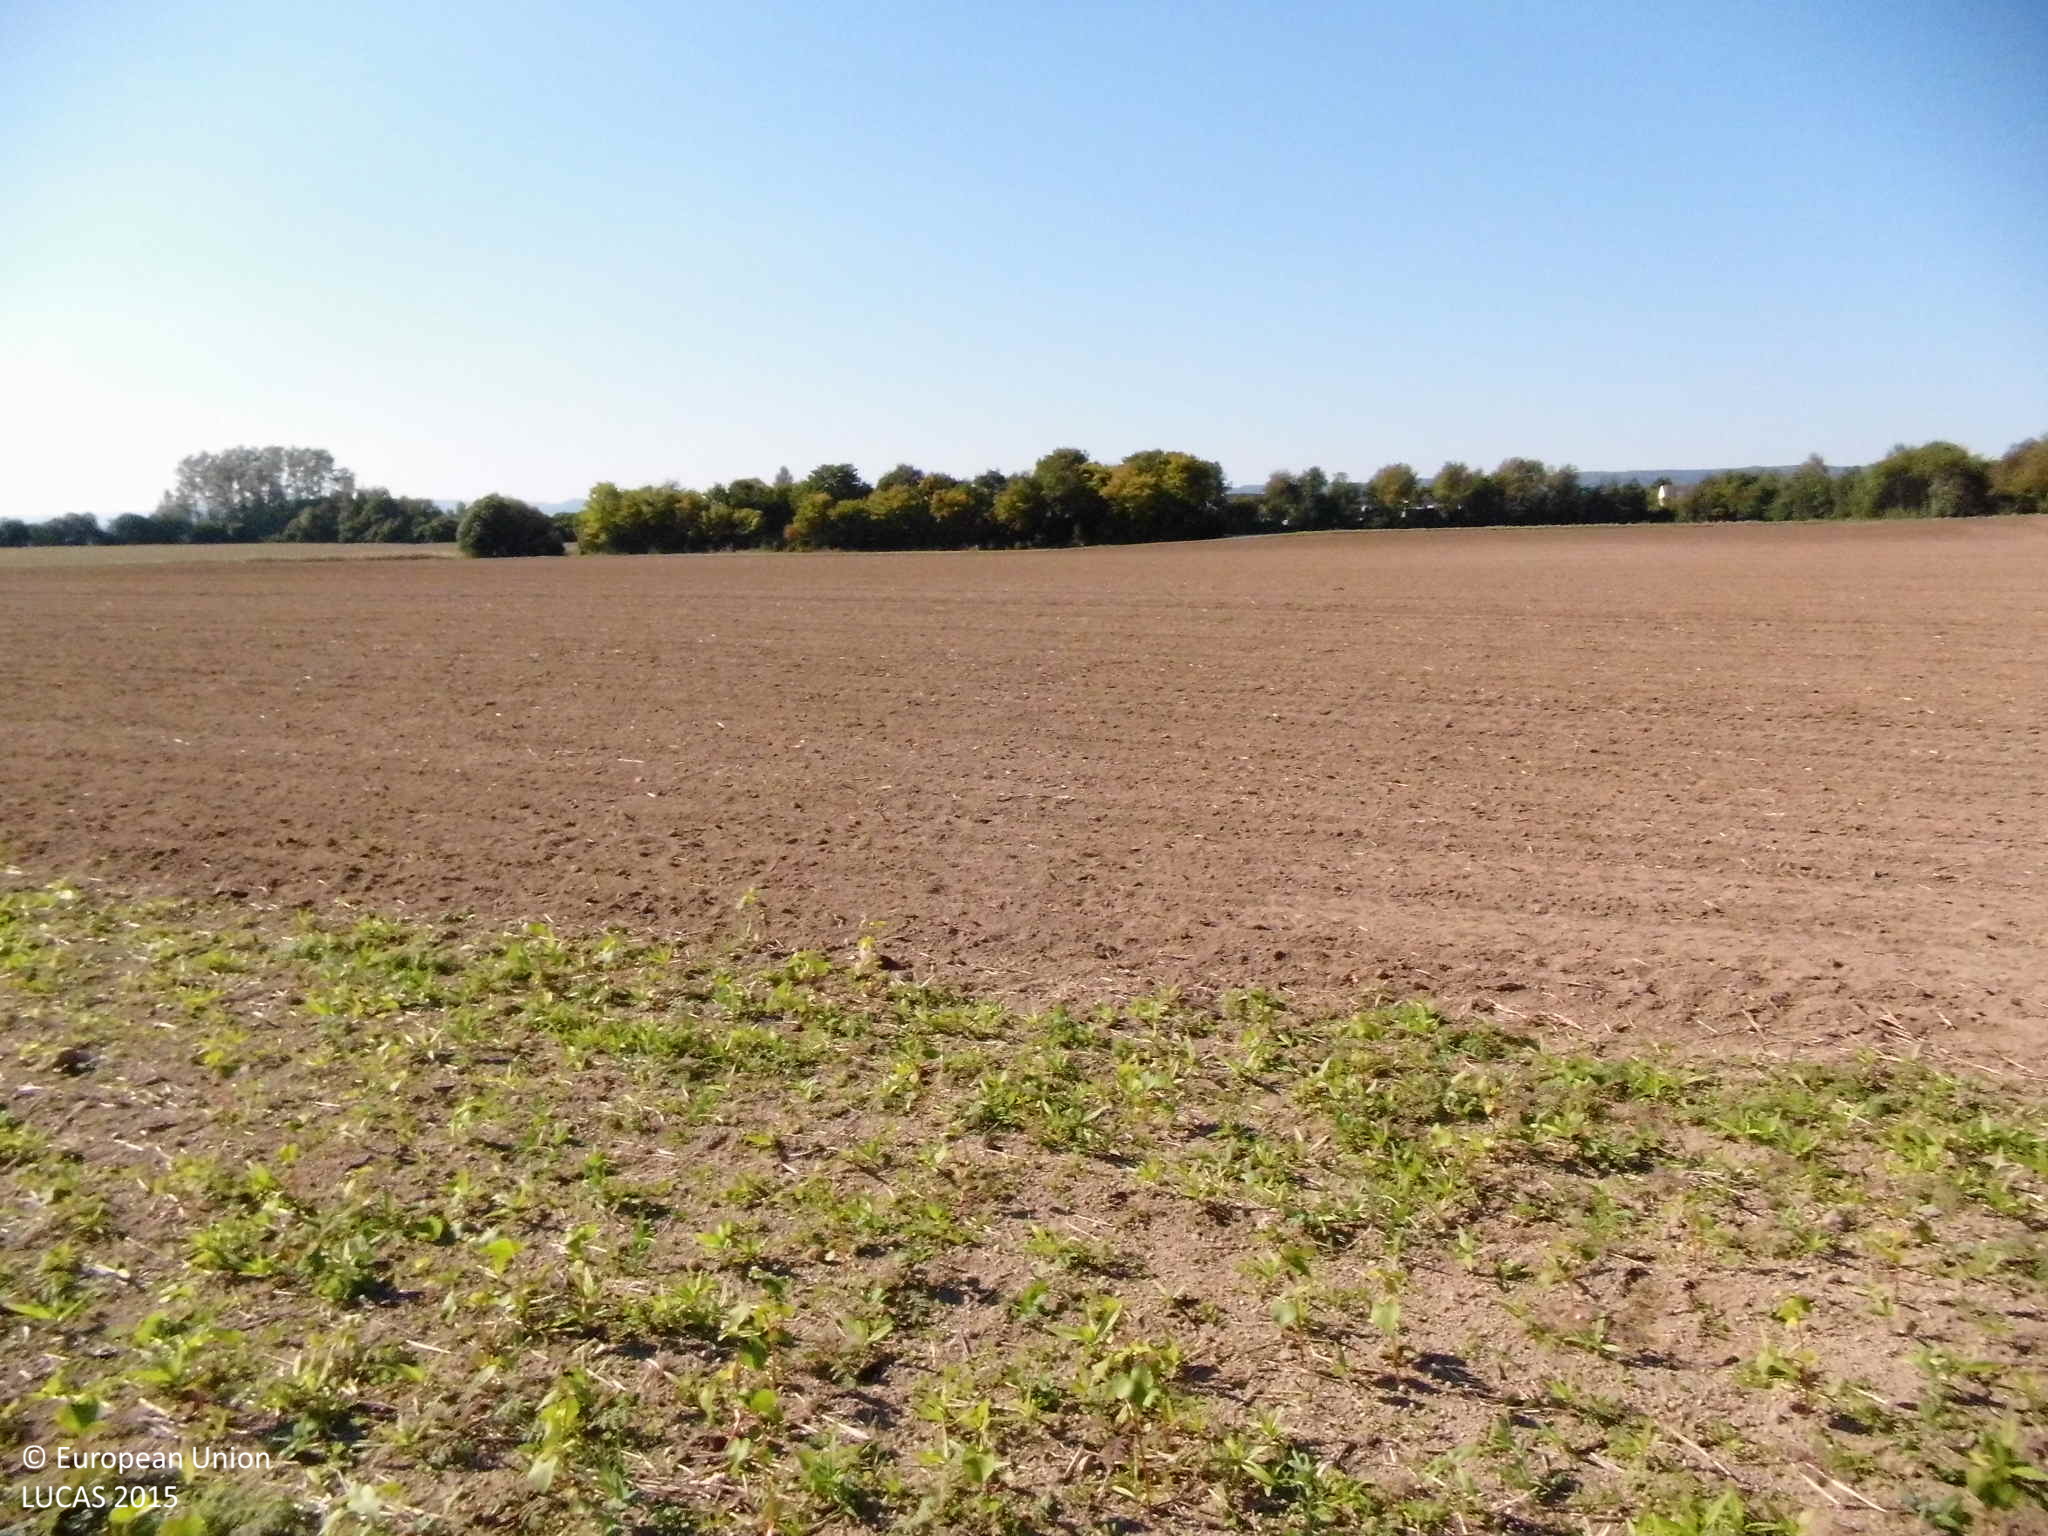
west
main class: Cropland
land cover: Other cereals
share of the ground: 10 - 25 %
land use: Agriculture (excluding fallow land and kitchen gardens)
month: October
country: DE
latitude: 50.4455
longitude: 7.5359
